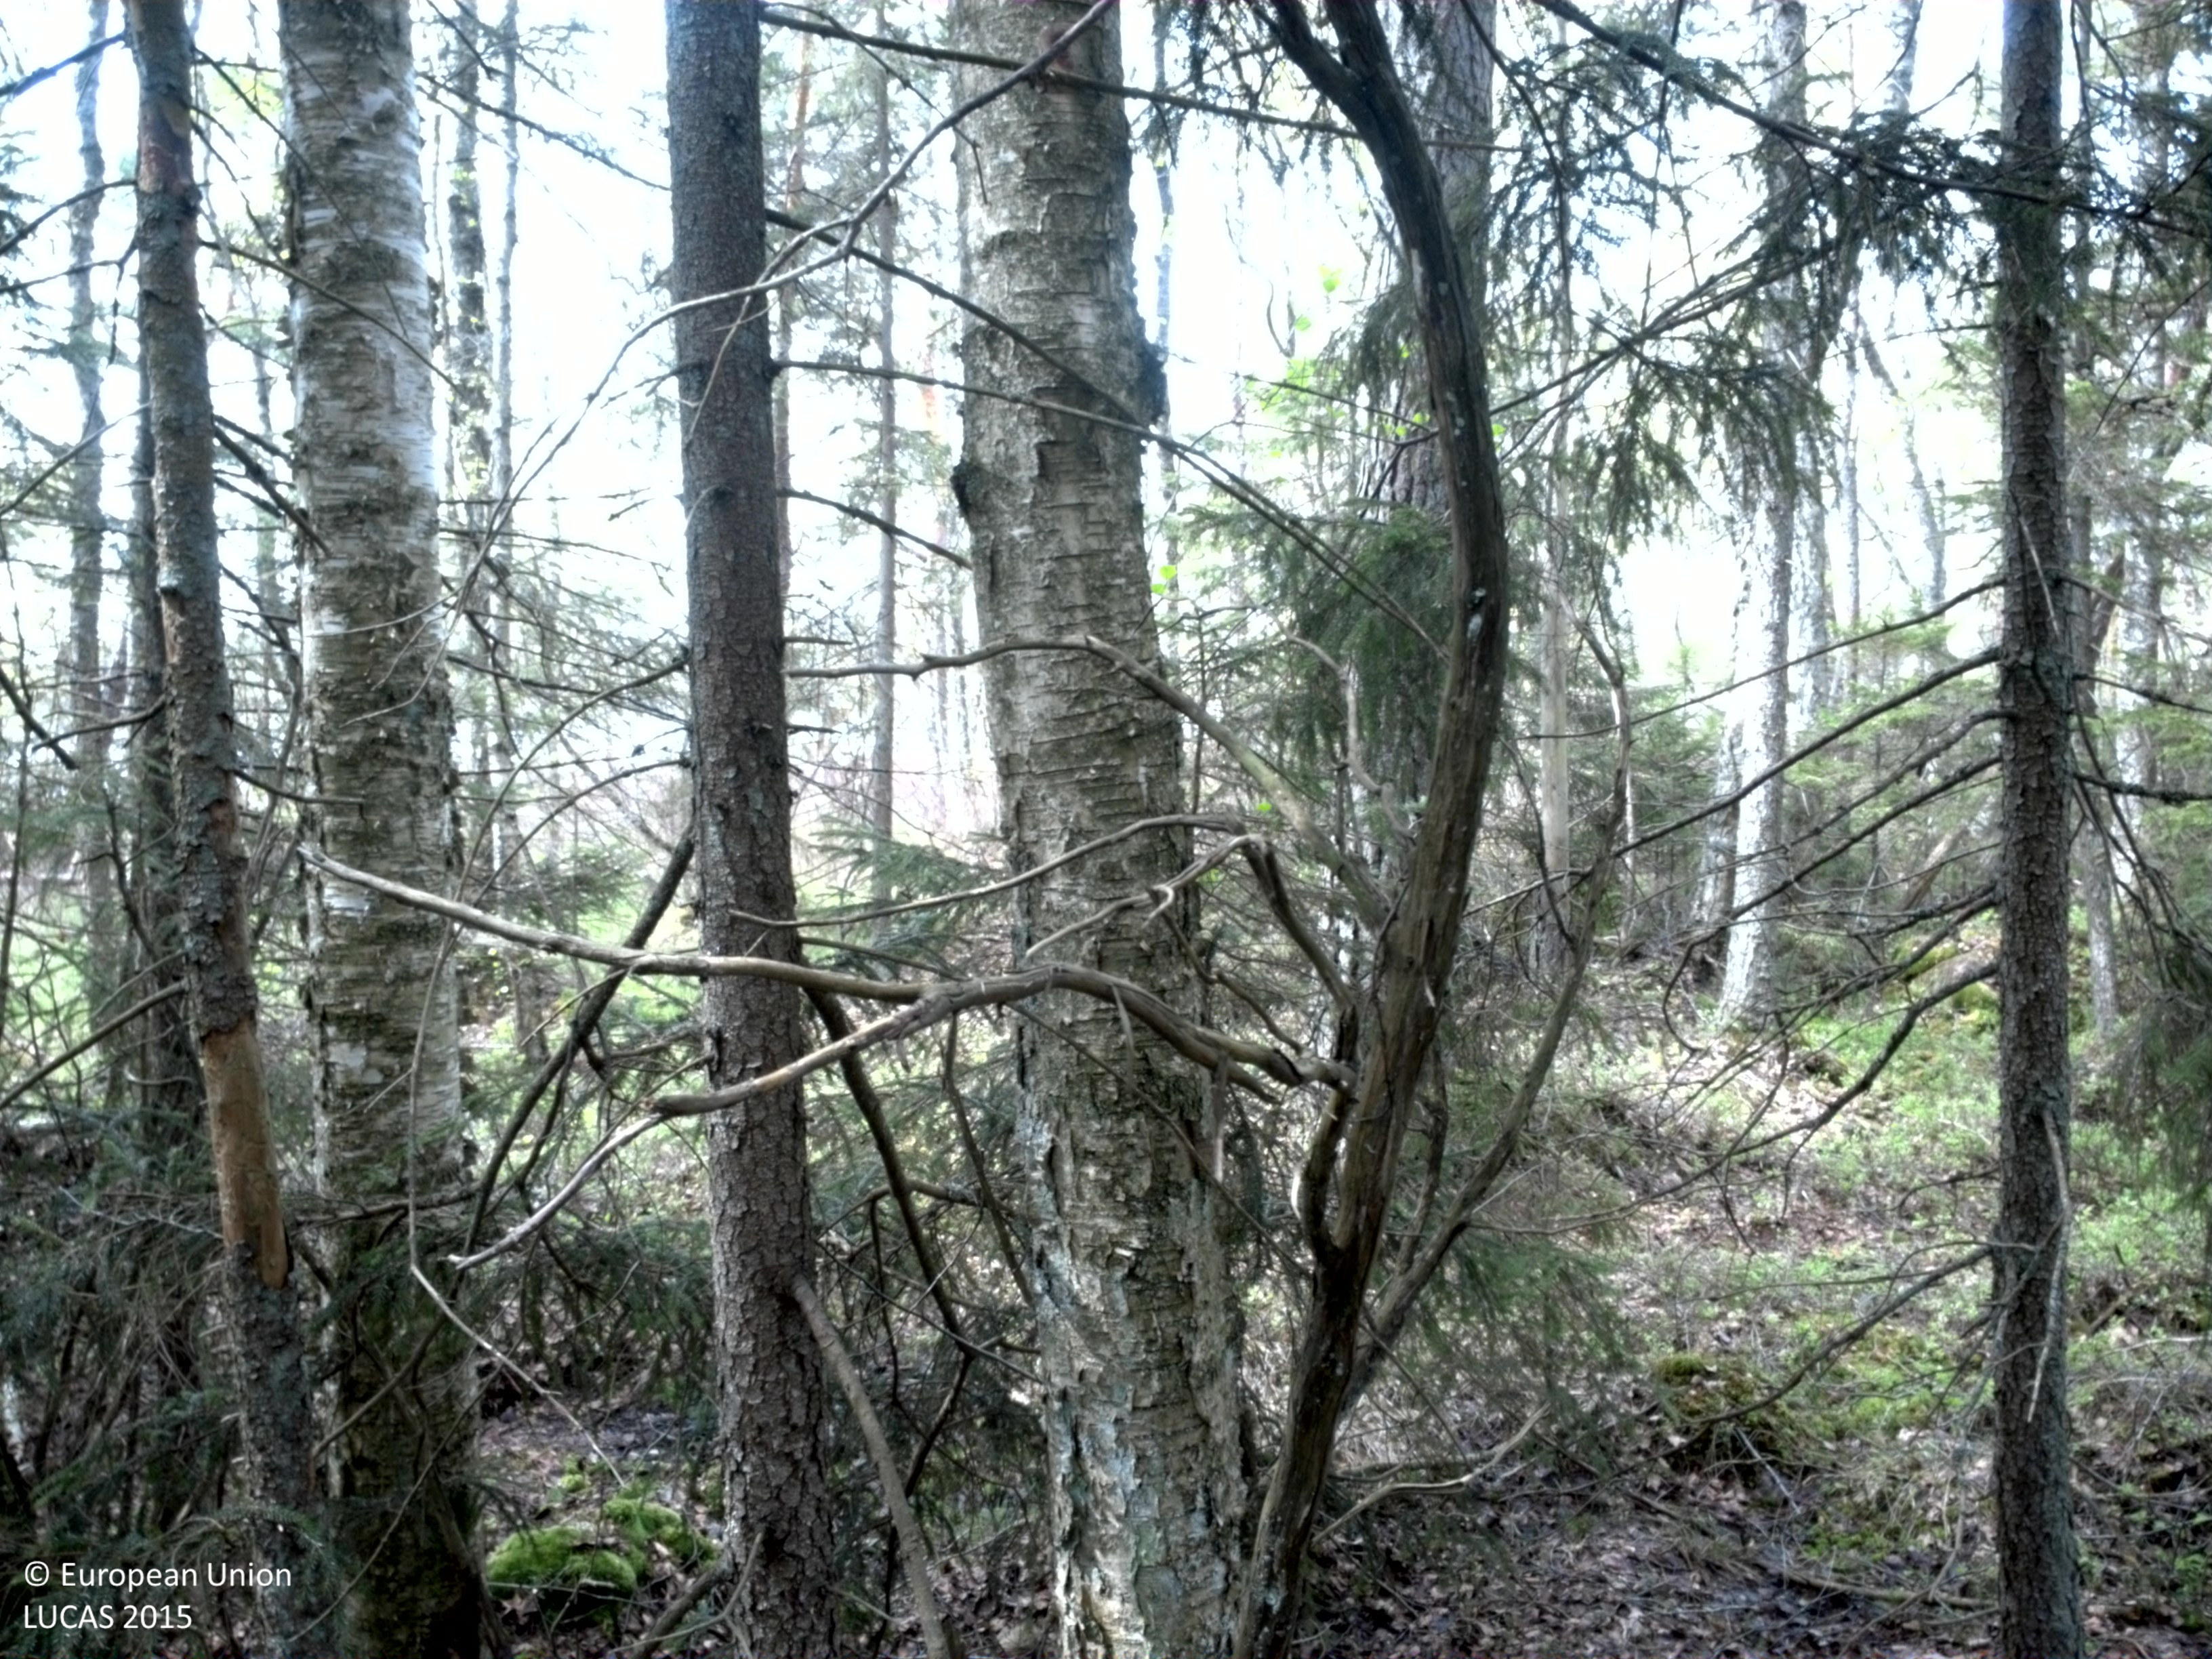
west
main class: Woodland
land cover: Spruce dominated mixed woodland
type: boreal forest
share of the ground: > 75 %
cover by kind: broadleaved forest trees 50 %, coniferous forest trees 40 %, lichens and mosses 10 %
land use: Forestry
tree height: > 5 m
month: May
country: SE
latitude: 56.7908
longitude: 15.0562
